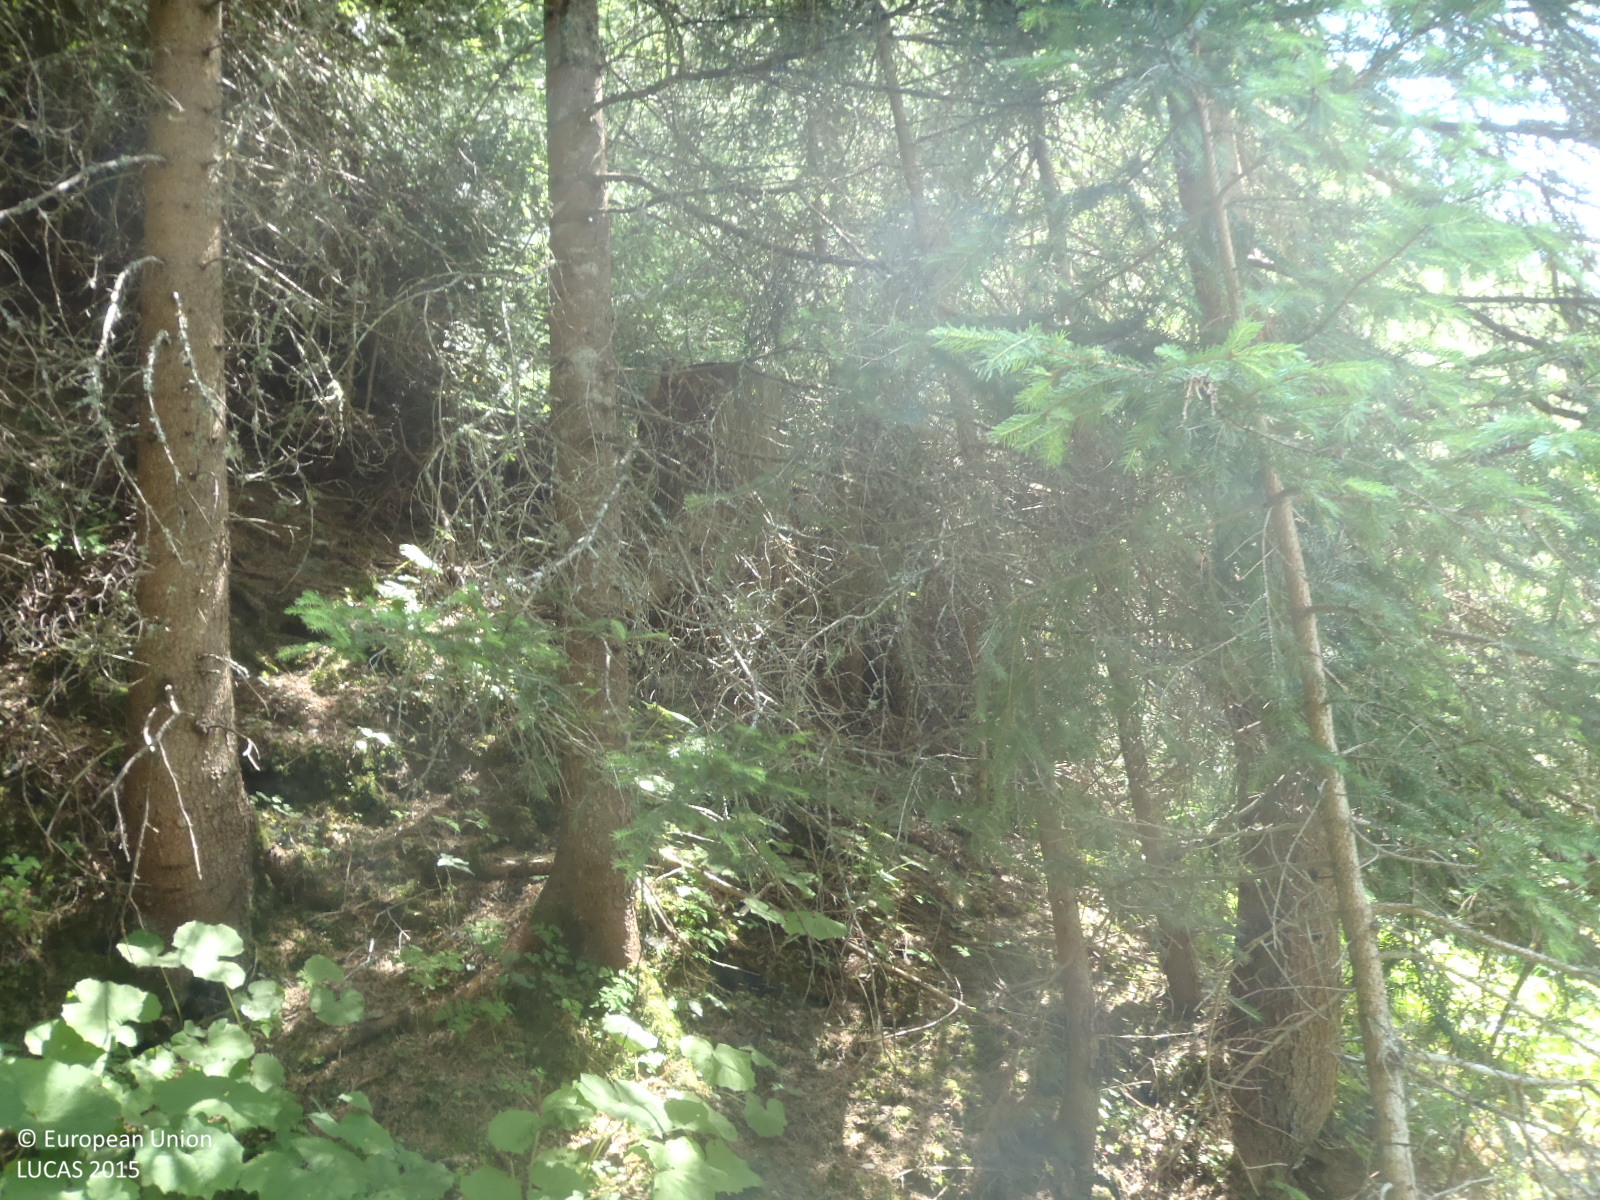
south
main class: Woodland
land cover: Spruce dominated coniferous woodland
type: alpine coniferous forest
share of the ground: > 75 %
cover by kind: coniferous forest trees 85 %, herbaceous plants 10 %, lichens and mosses 5 %
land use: Forestry
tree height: > 5 m
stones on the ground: < 10 %
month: July
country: AT
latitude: 47.0885
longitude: 10.4869
